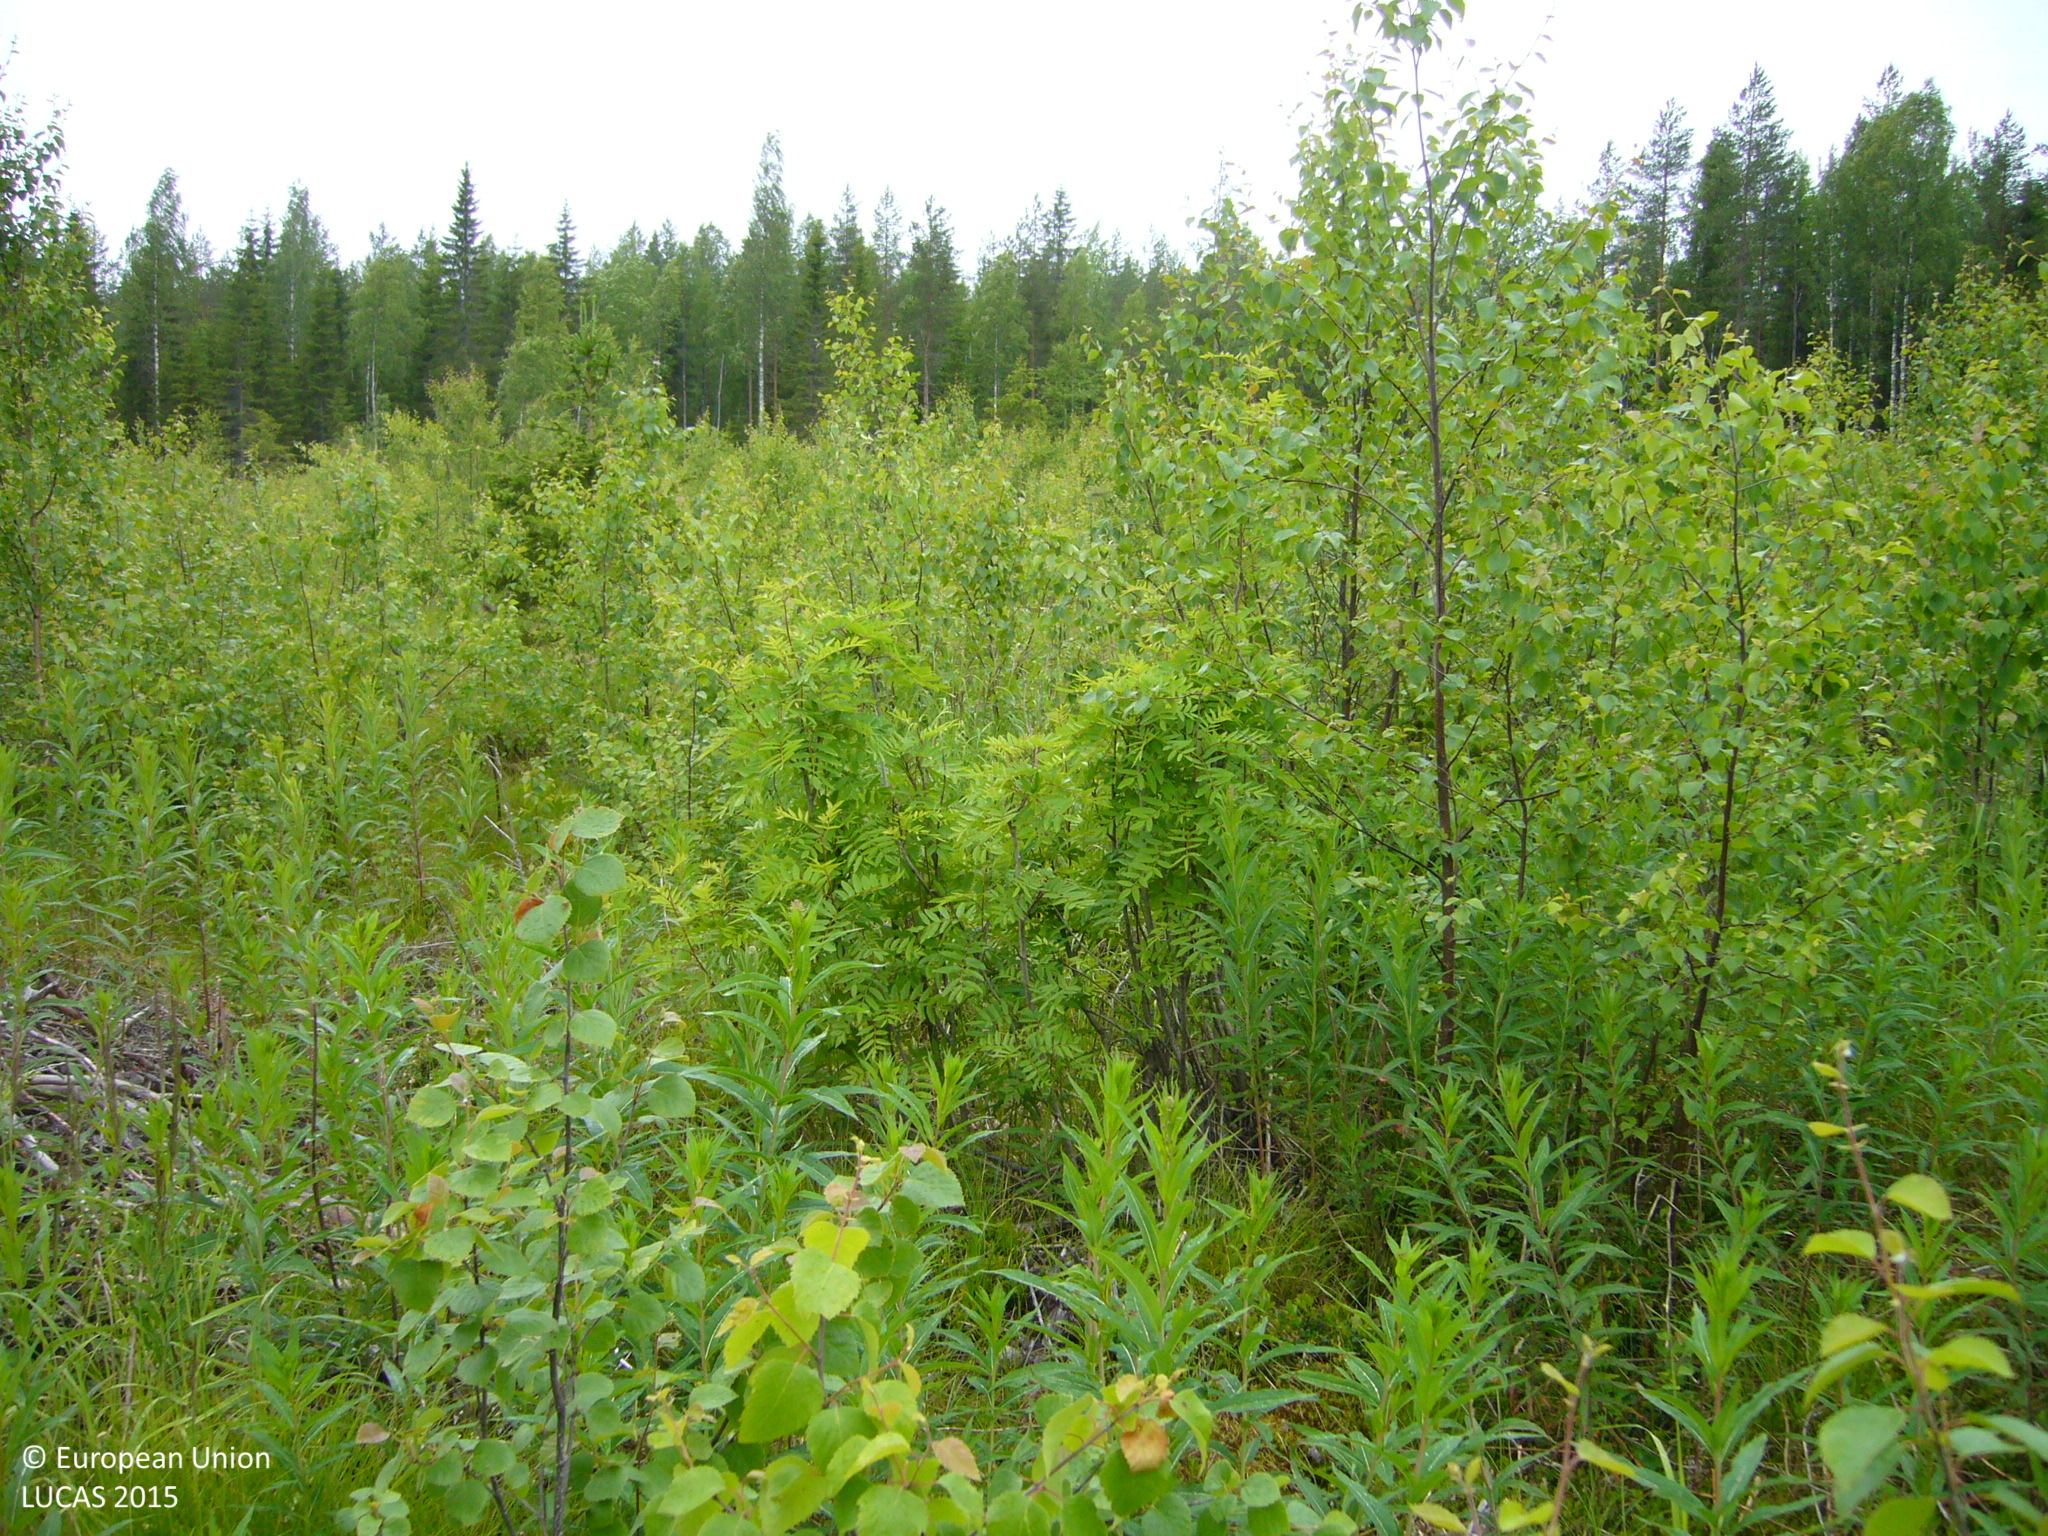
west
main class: Woodland
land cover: Spruce dominated mixed woodland
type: boreal forest
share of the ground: > 75 %
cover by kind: broadleaved forest trees 50 %, coniferous forest trees 25 %, shrubs 25 %
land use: Forestry
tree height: < 5 m
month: July
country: FI
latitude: 63.4285
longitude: 25.8400
